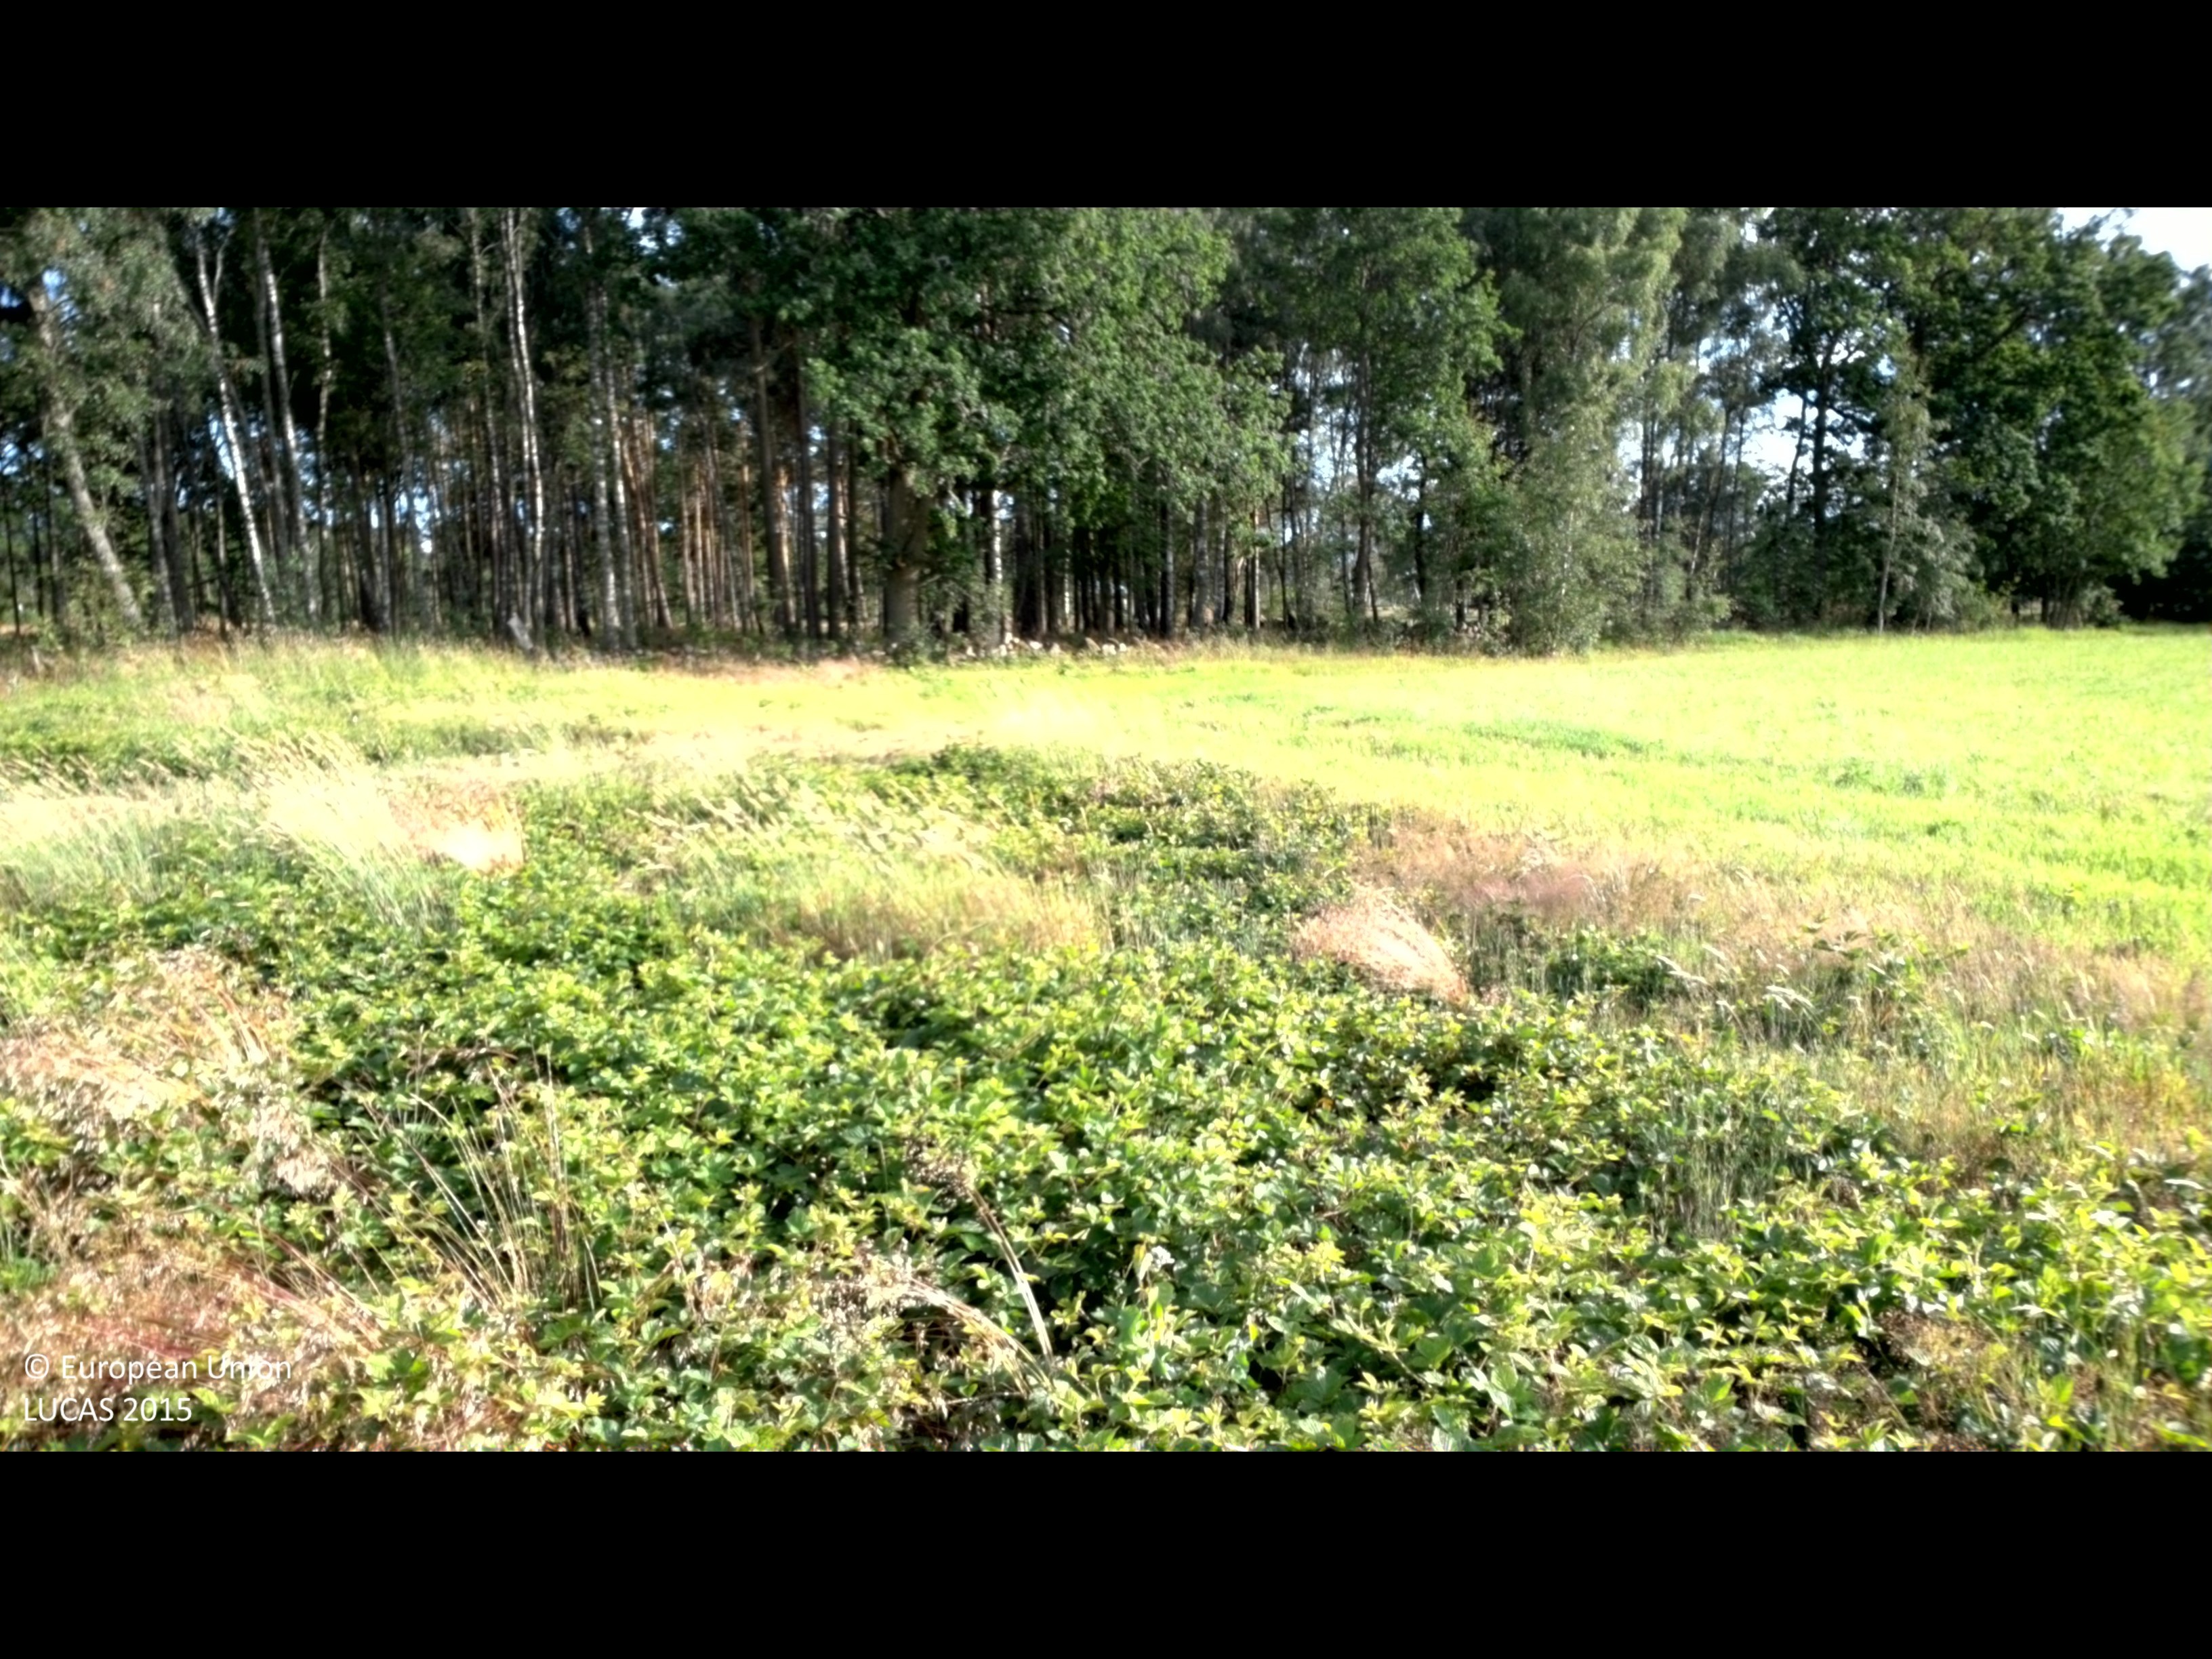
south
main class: Shrubland
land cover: Shrubland without tree cover
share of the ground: > 75 %
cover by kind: shrubs 85 %, herbaceous plants 15 %
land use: Semi-natural and natural areas not in use
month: July
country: SE
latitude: 57.1524
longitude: 16.9943
